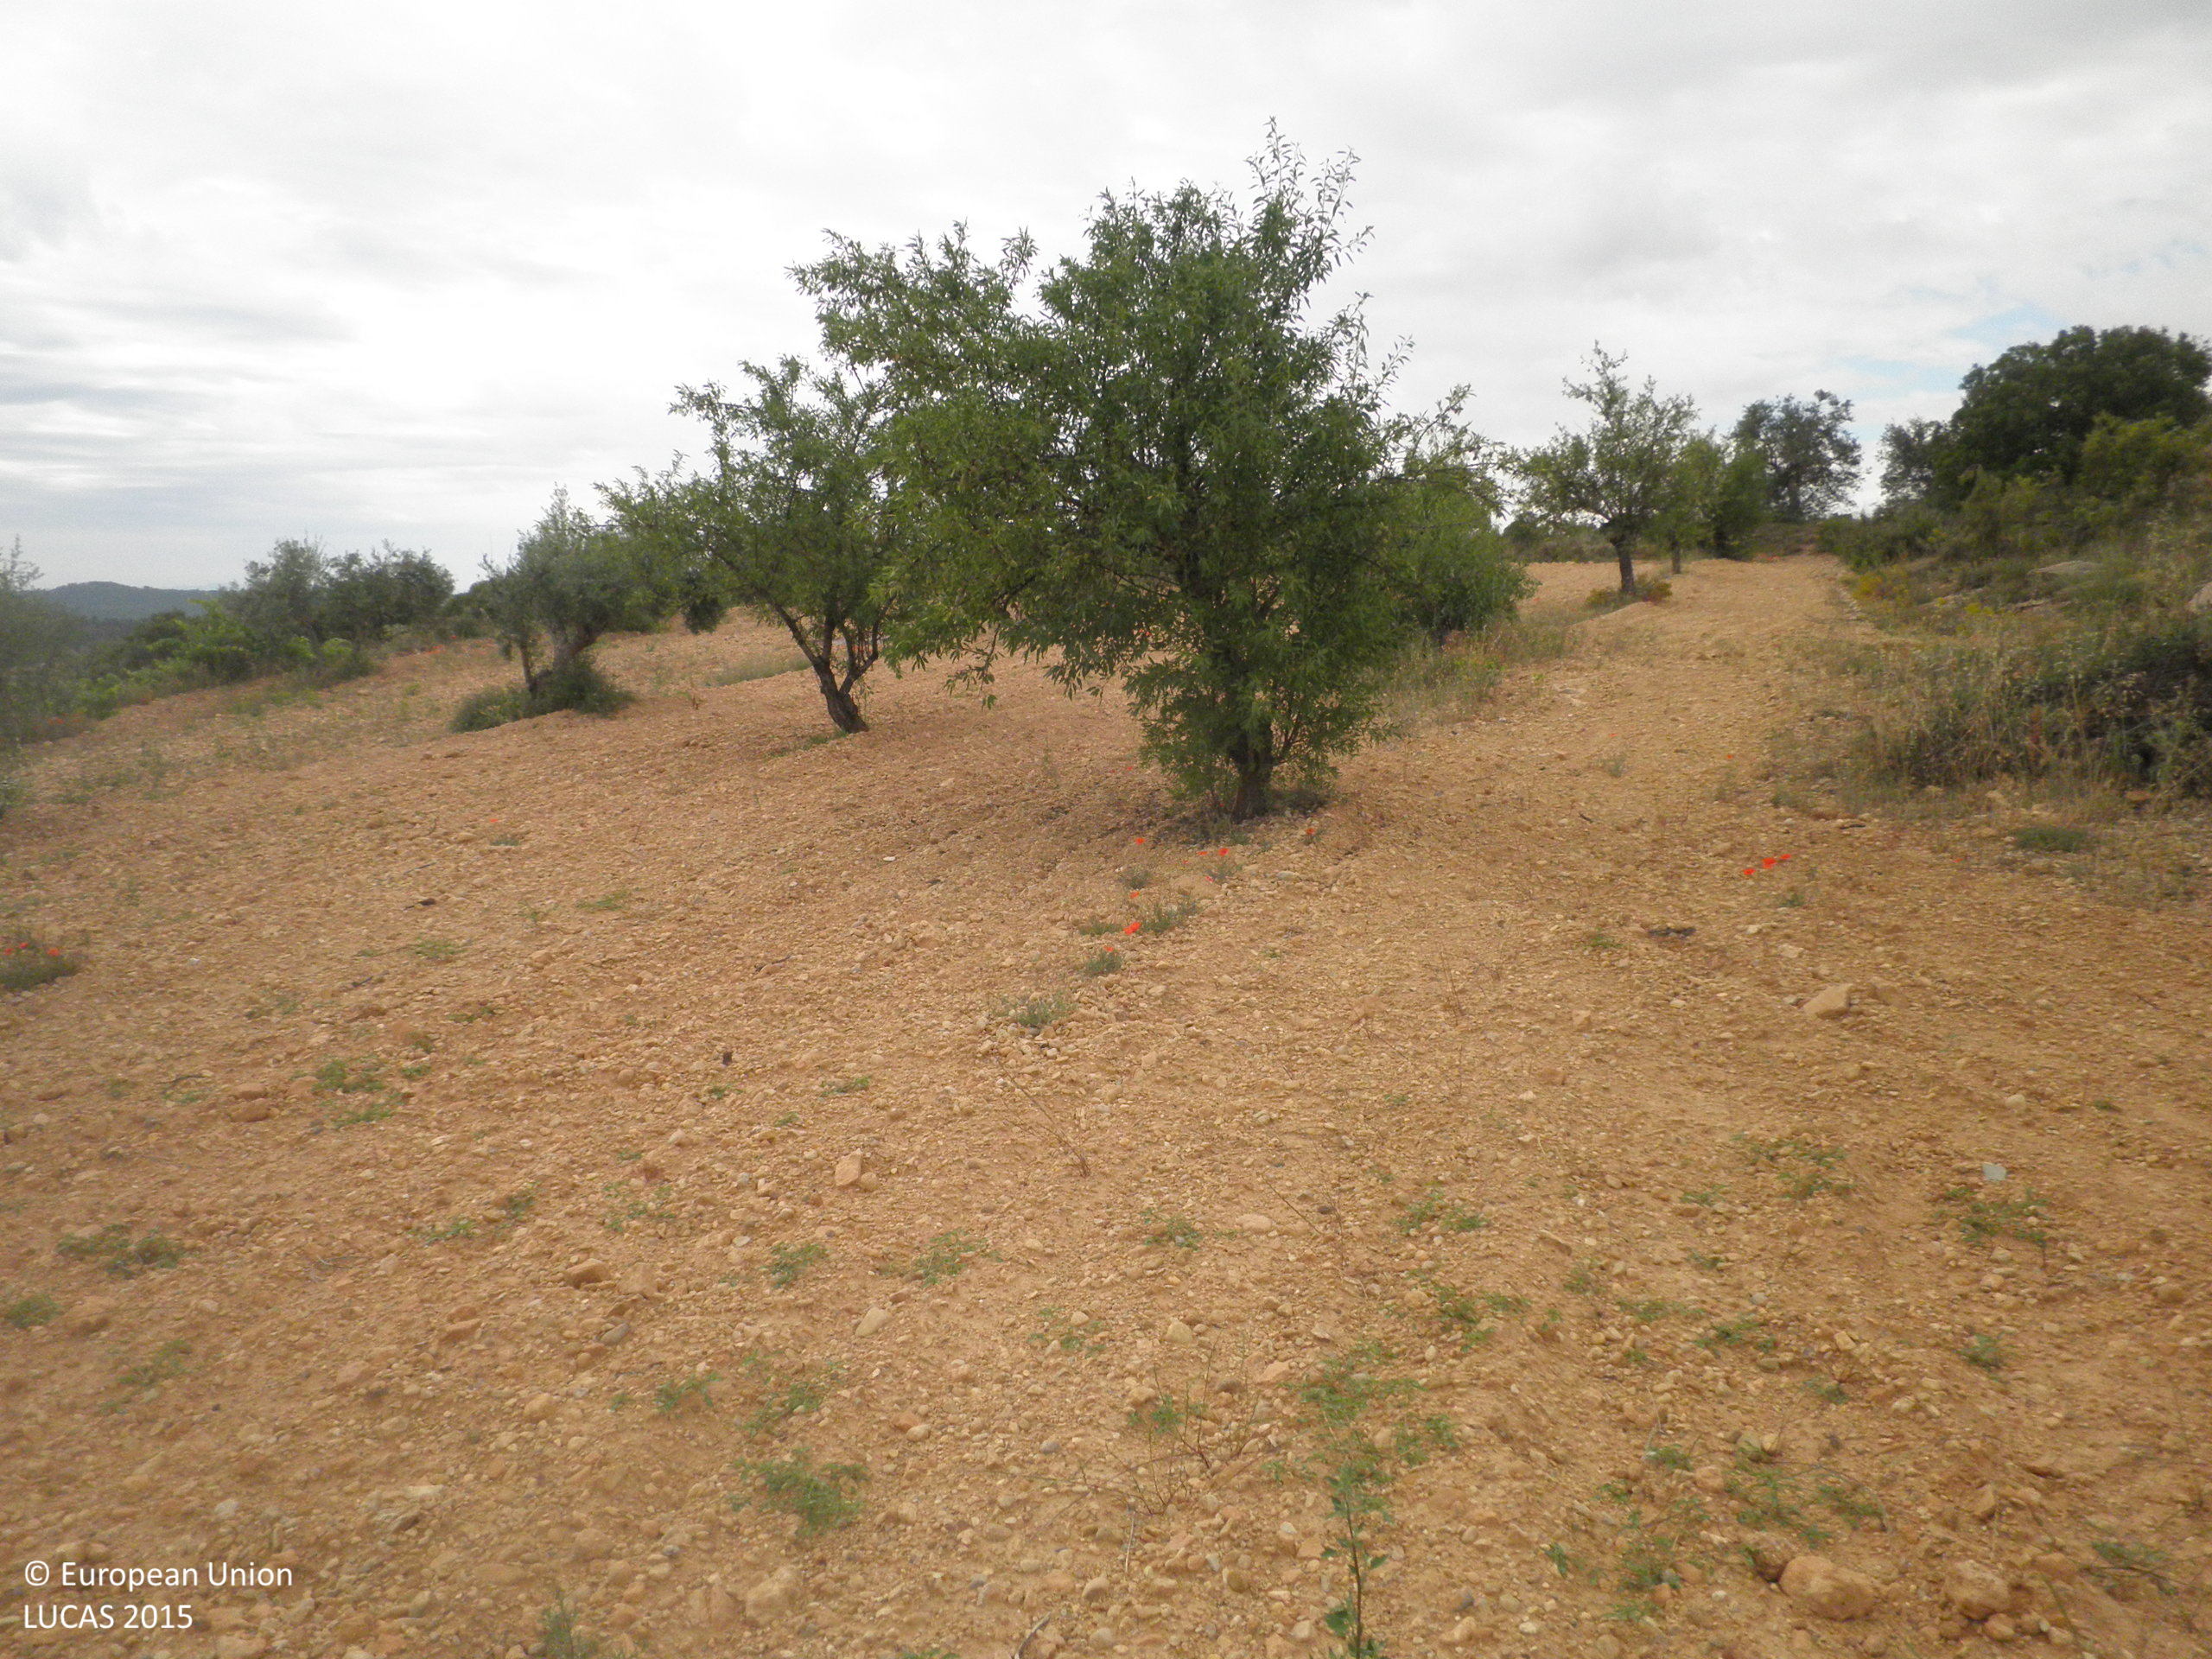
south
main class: Cropland
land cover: Olive groves
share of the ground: < 10 %
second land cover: Spontaneously vegetated surfaces
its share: > 75 %
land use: Agriculture (excluding fallow land and kitchen gardens)
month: June
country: ES
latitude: 39.5781
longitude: -1.5893
